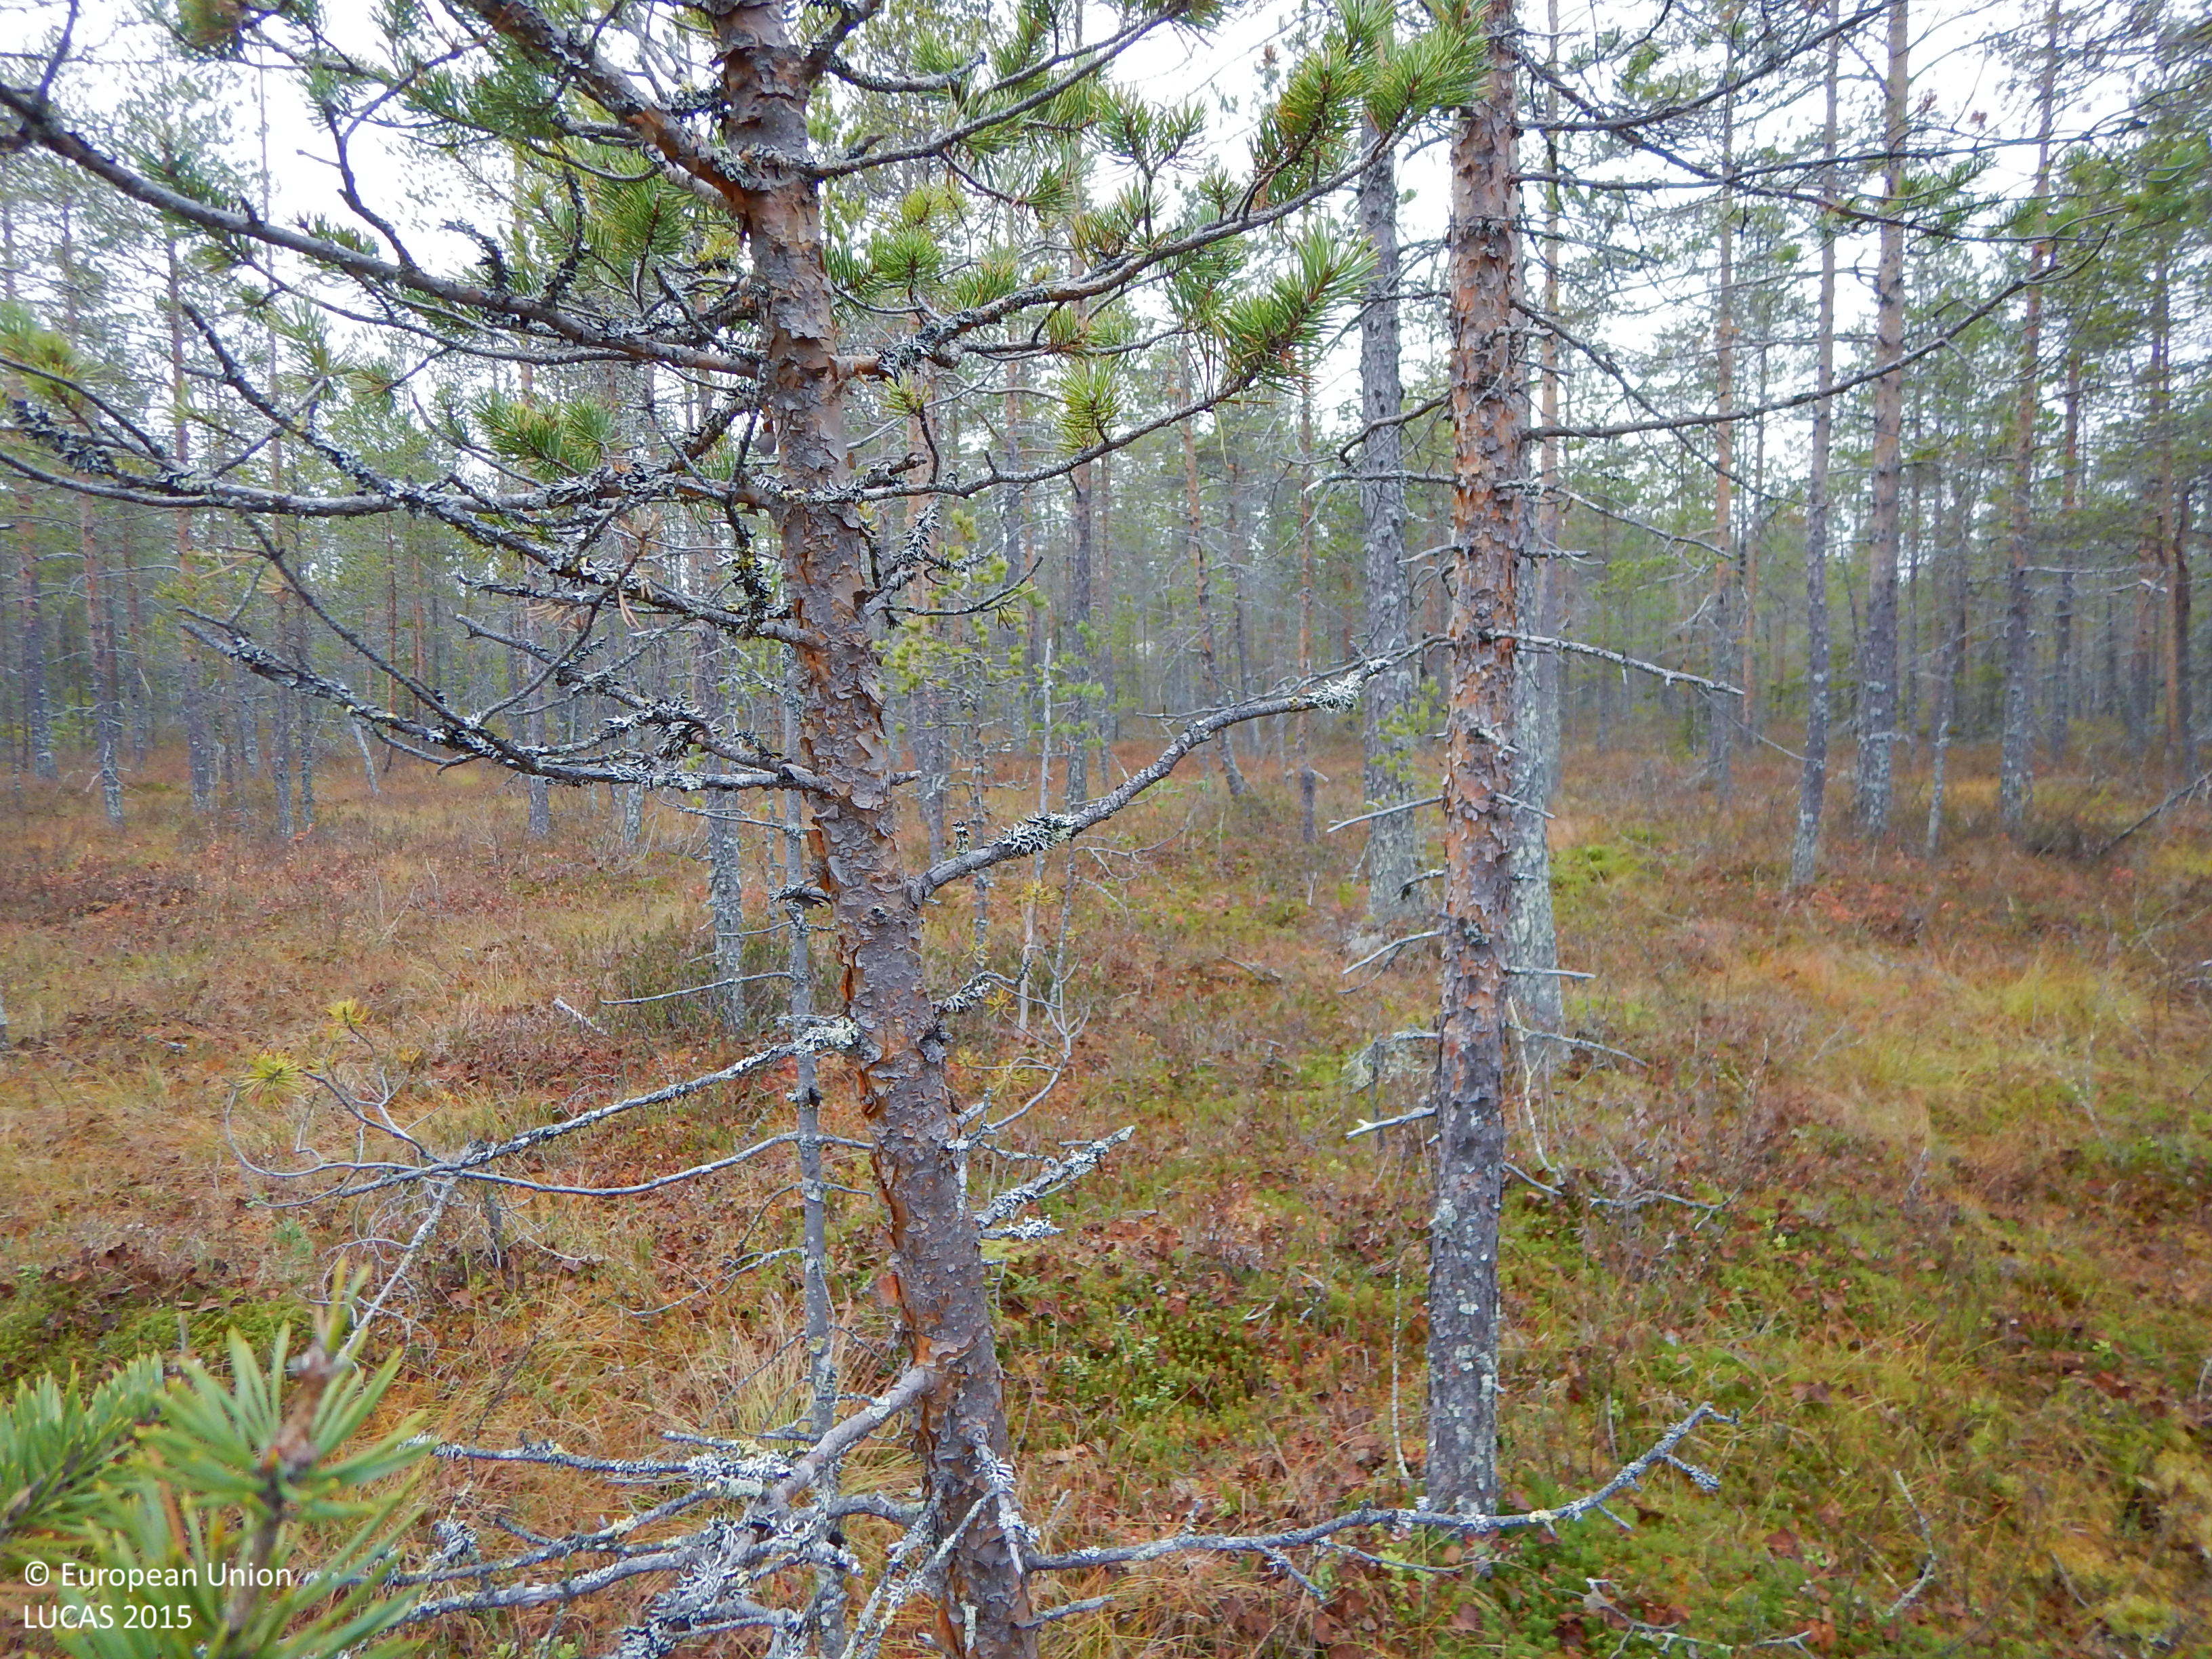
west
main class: Woodland
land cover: Pine dominated coniferous woodland
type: mire and swamp forests
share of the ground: 25 - 50 %
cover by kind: coniferous forest trees 40 %, lichens and mosses 30 %, shrubs 20 %, herbaceous plants 10 %
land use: Semi-natural and natural areas not in use
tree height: > 5 m
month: October
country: SE
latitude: 65.1010
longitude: 21.1515
